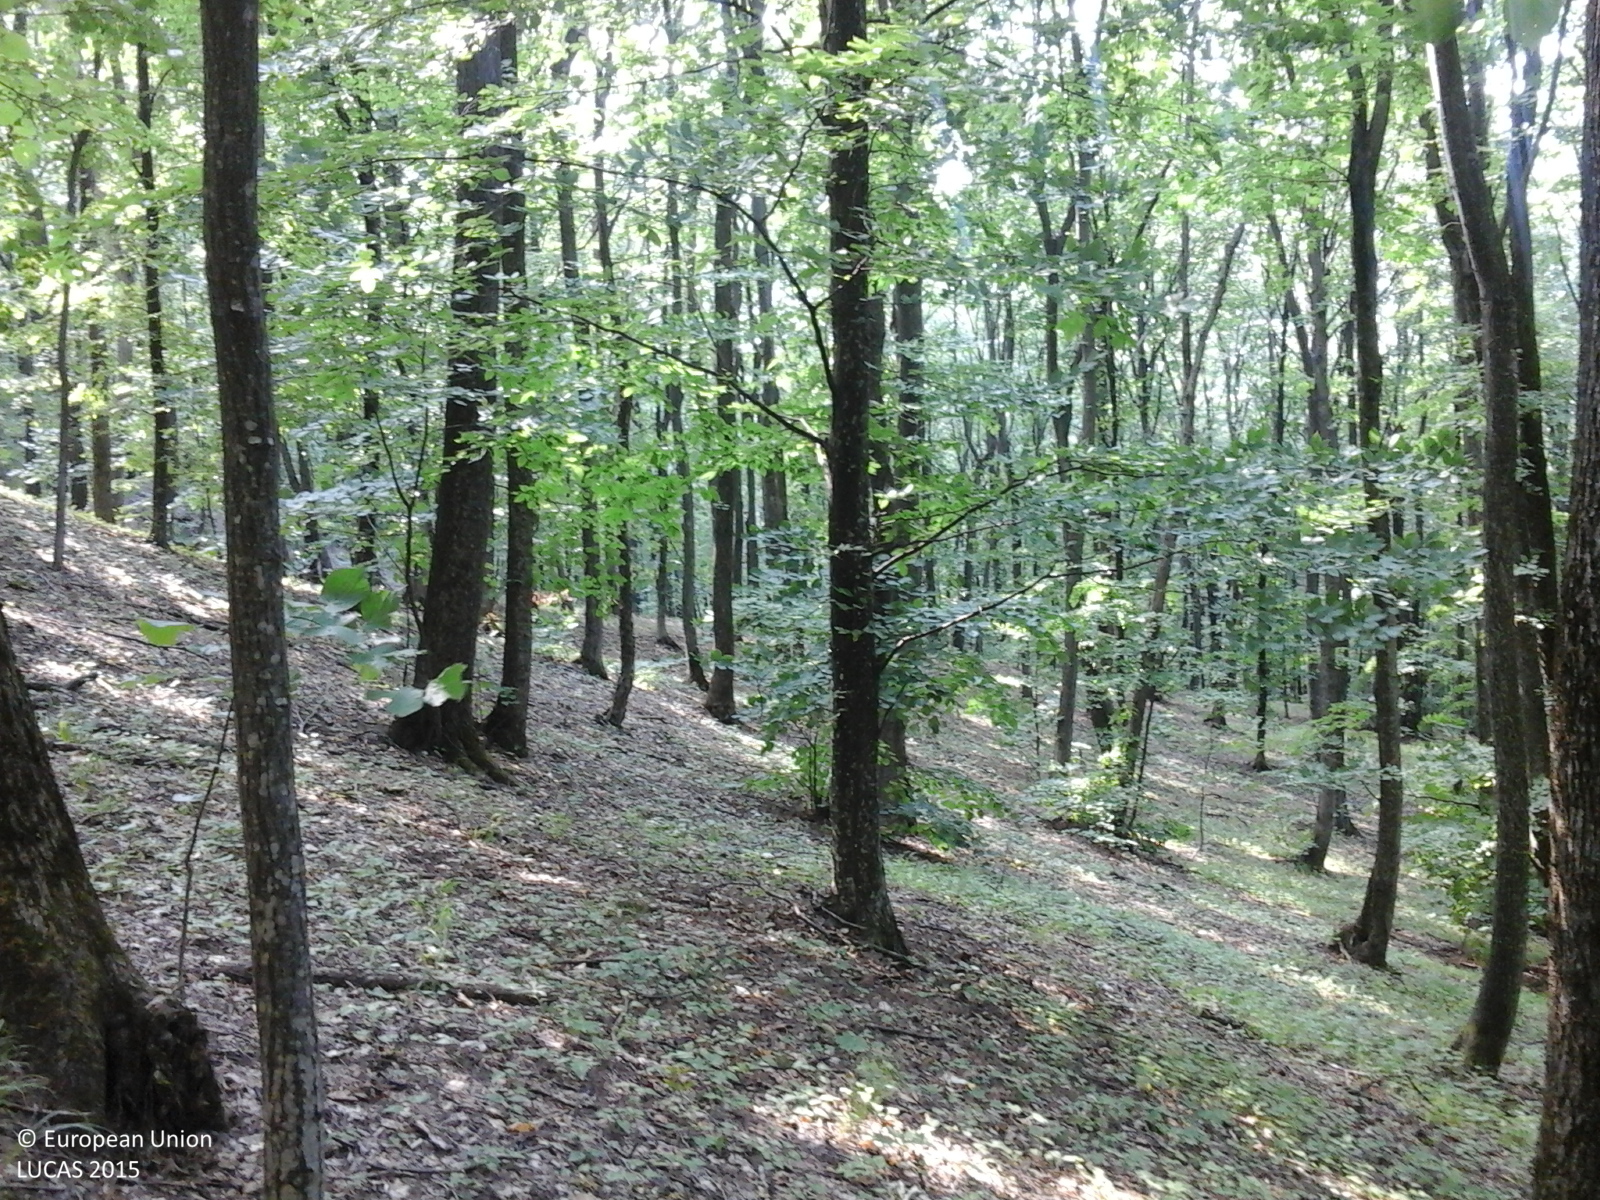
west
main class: Woodland
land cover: Broadleaved woodland
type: mesophytic deciduous forest
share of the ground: > 75 %
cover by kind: broadleaved forest trees 100 %
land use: Forestry
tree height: > 5 m
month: June
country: RO
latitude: 46.7994
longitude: 27.4457
